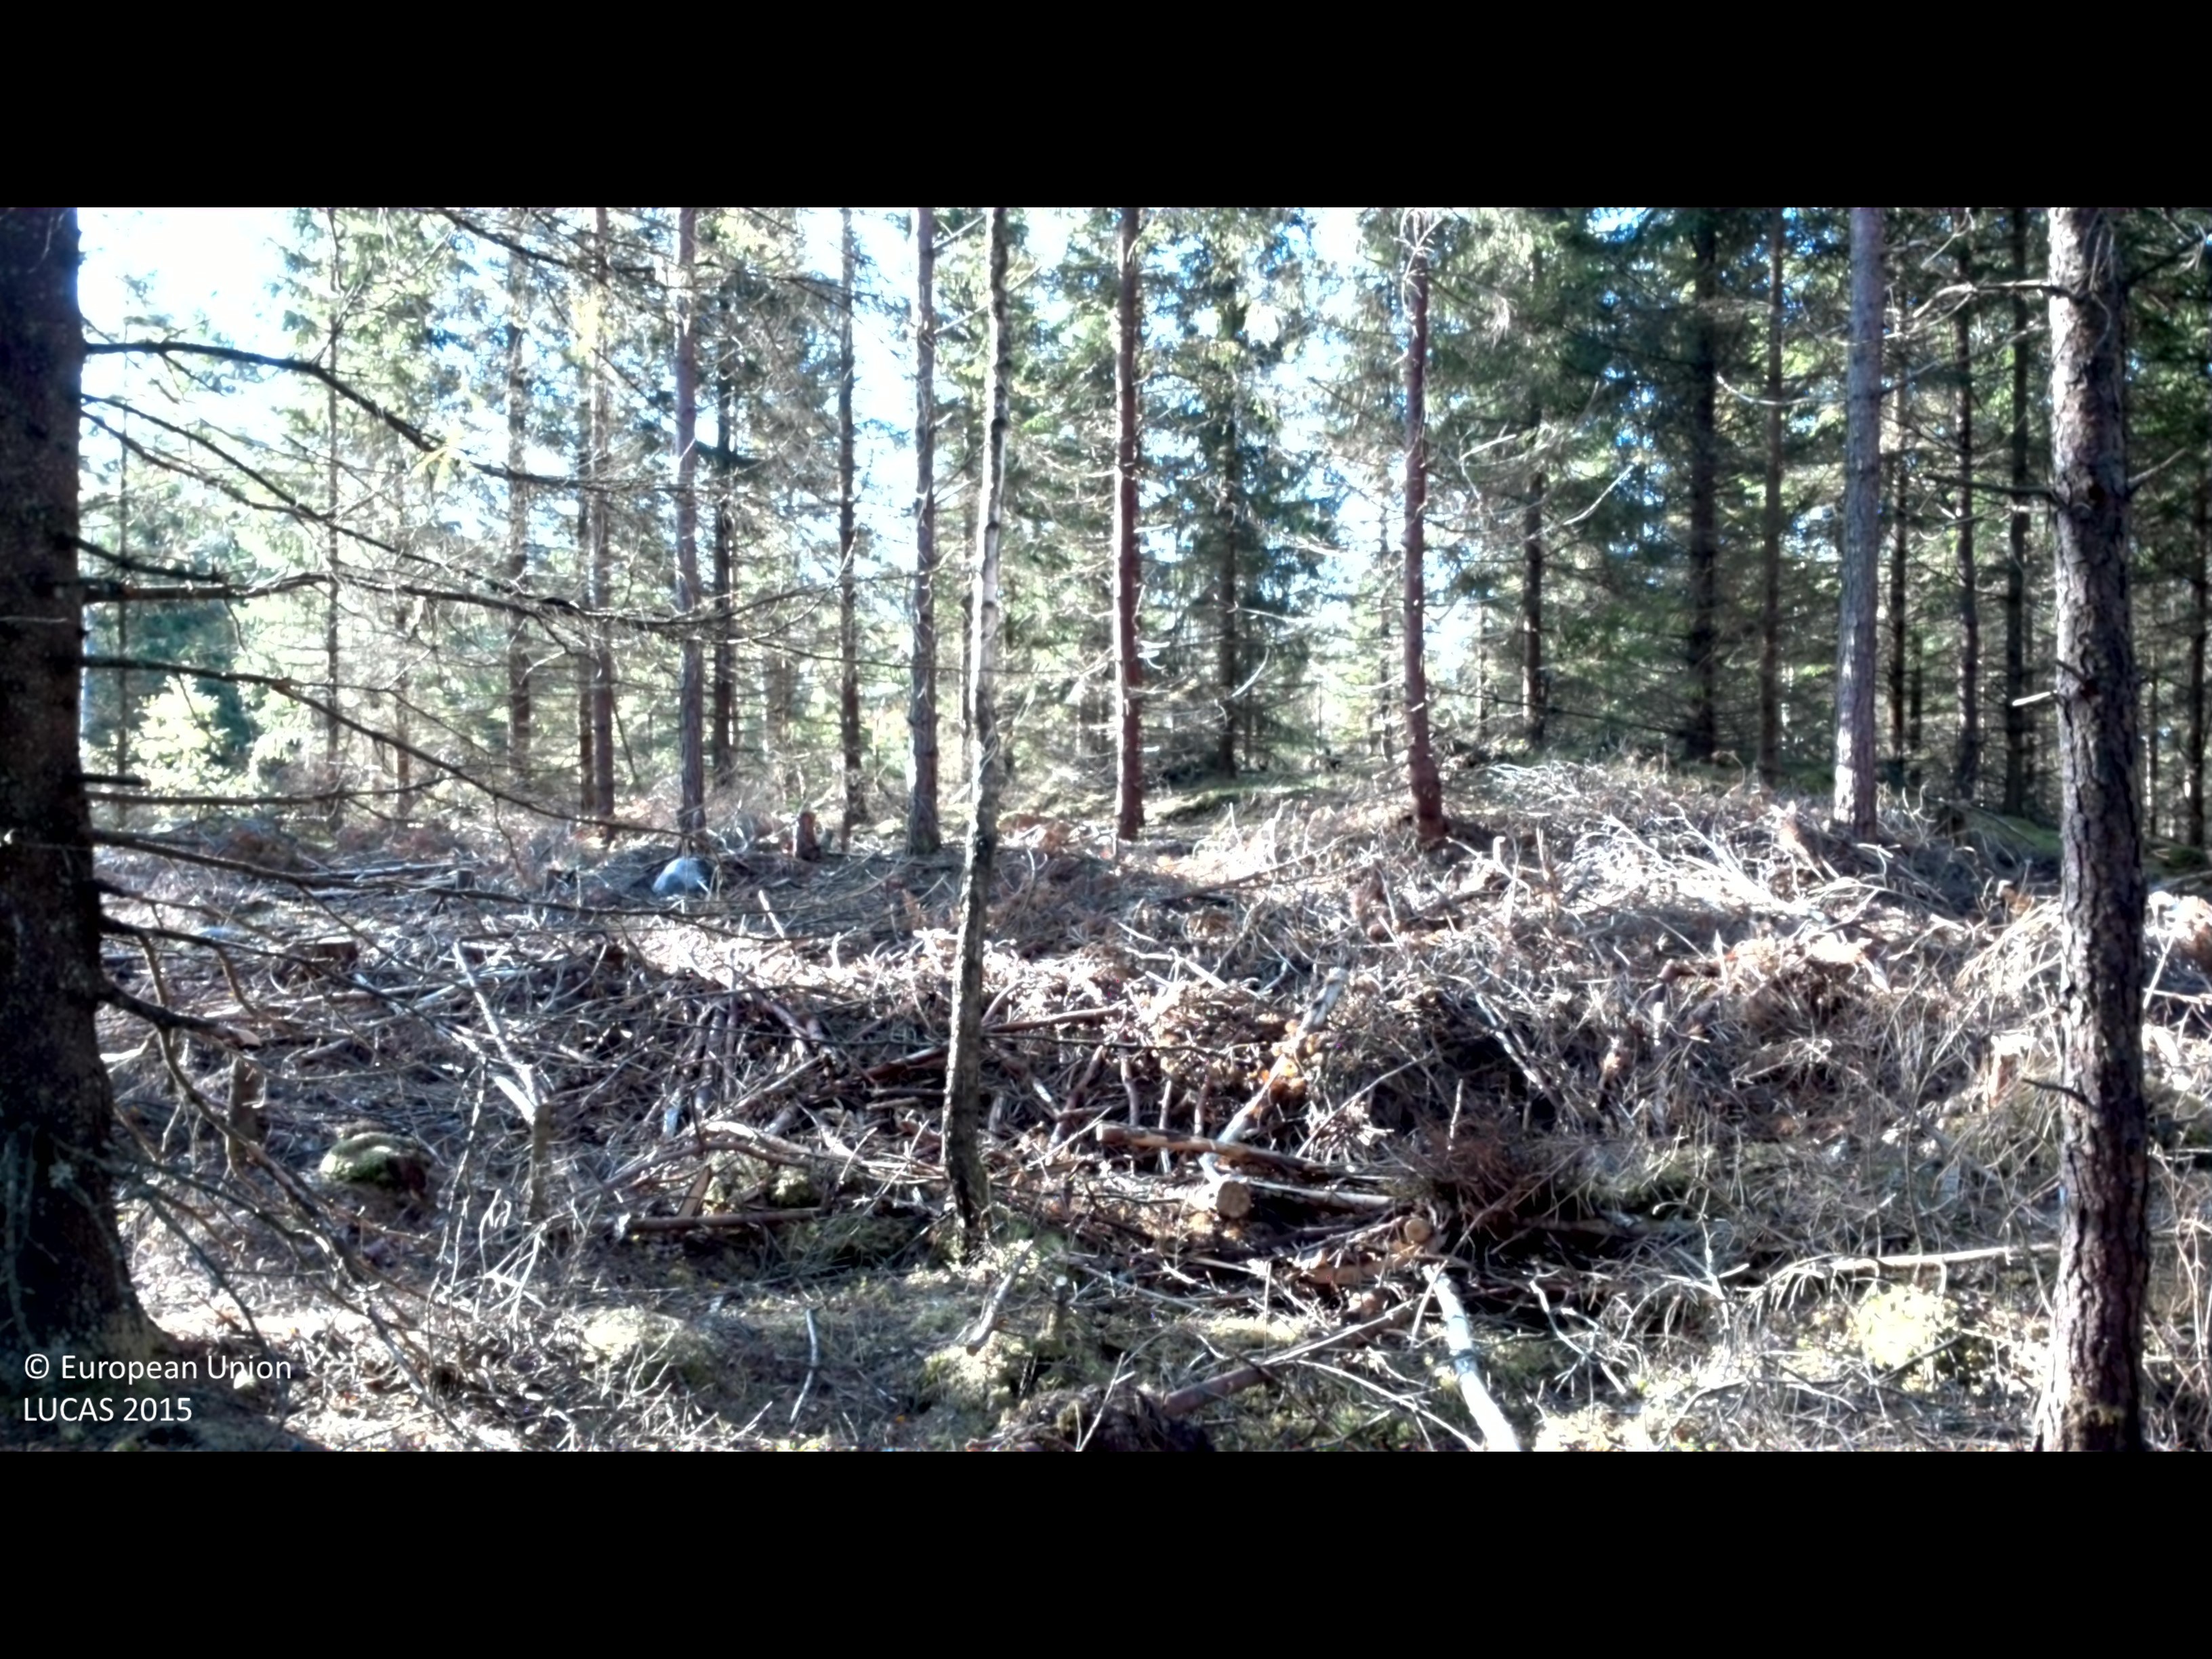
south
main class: Woodland
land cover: Spruce dominated mixed woodland
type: boreal forest
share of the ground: 50 - 75 %
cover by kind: coniferous forest trees 45 %, broadleaved forest trees 30 %, shrubs 10 %, lichens and mosses 10 %, herbaceous plants 5 %
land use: Forestry
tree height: > 5 m
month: September
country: SE
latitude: 57.0832
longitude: 13.2137
